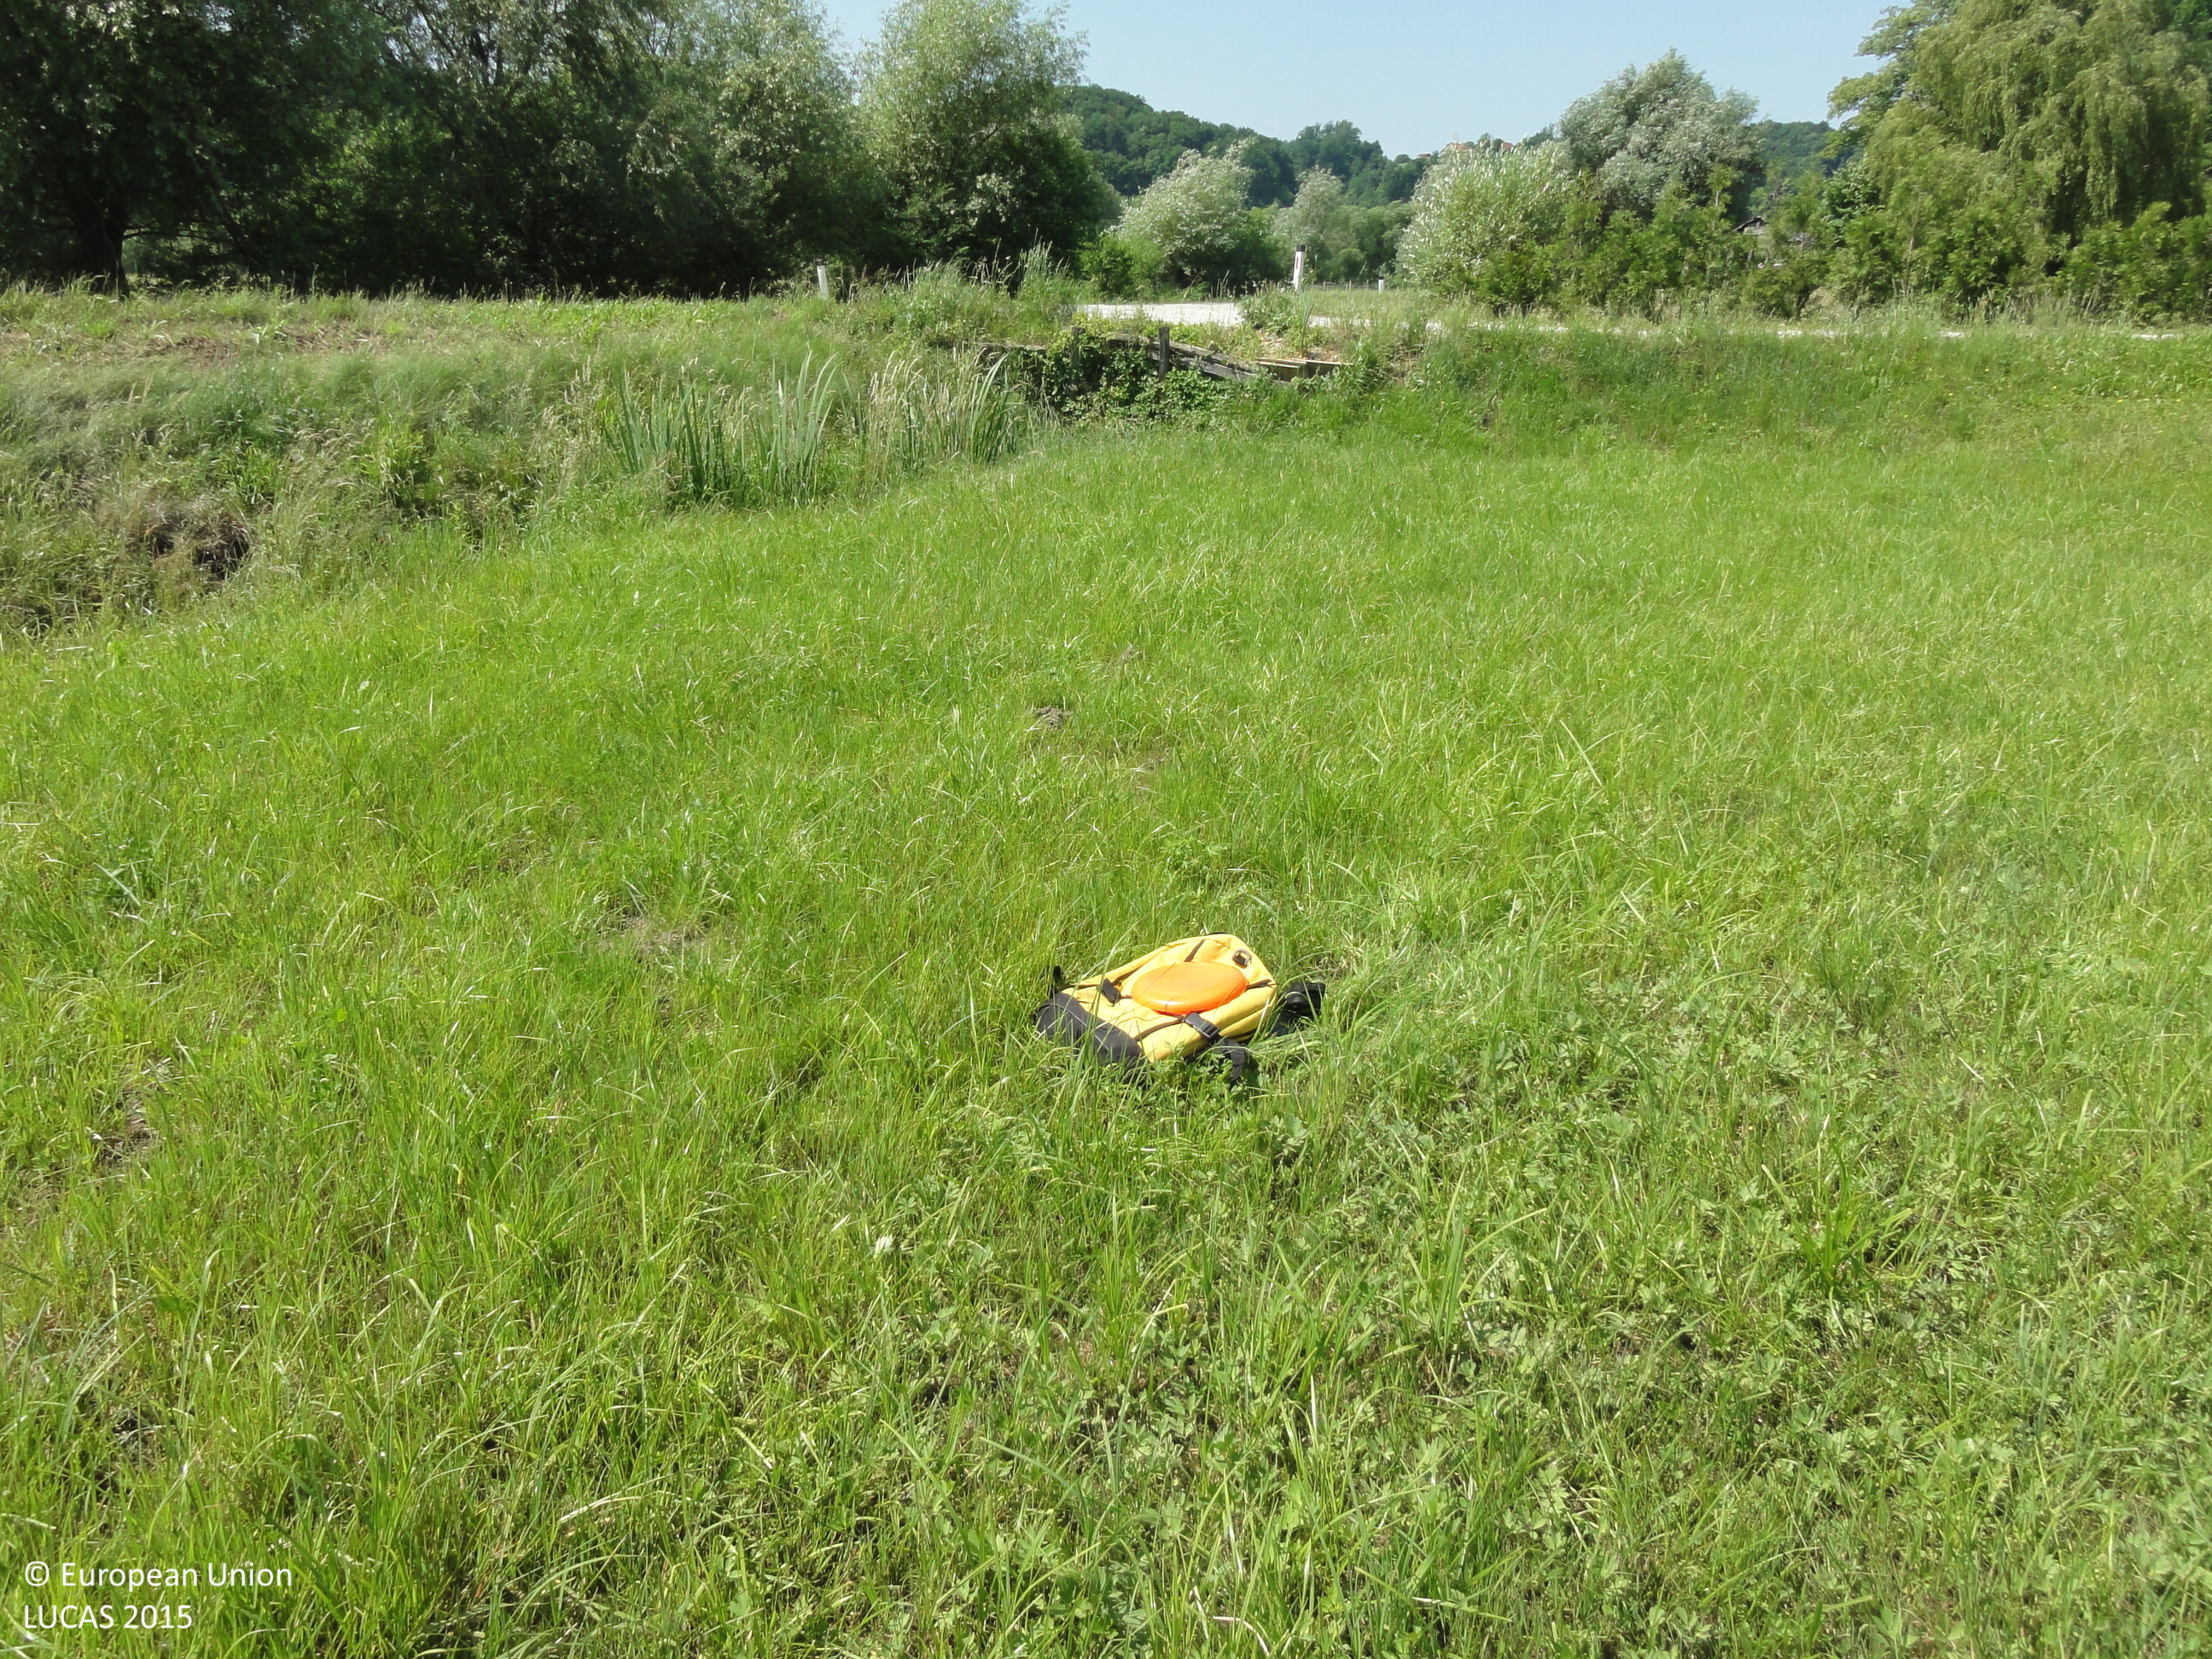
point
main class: Grassland
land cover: Grassland without tree/shrub cover
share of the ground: > 75 %
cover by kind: herbaceous plants 100 %
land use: Agriculture (excluding fallow land and kitchen gardens)
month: June
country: SI
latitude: 46.2992
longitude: 15.5158
